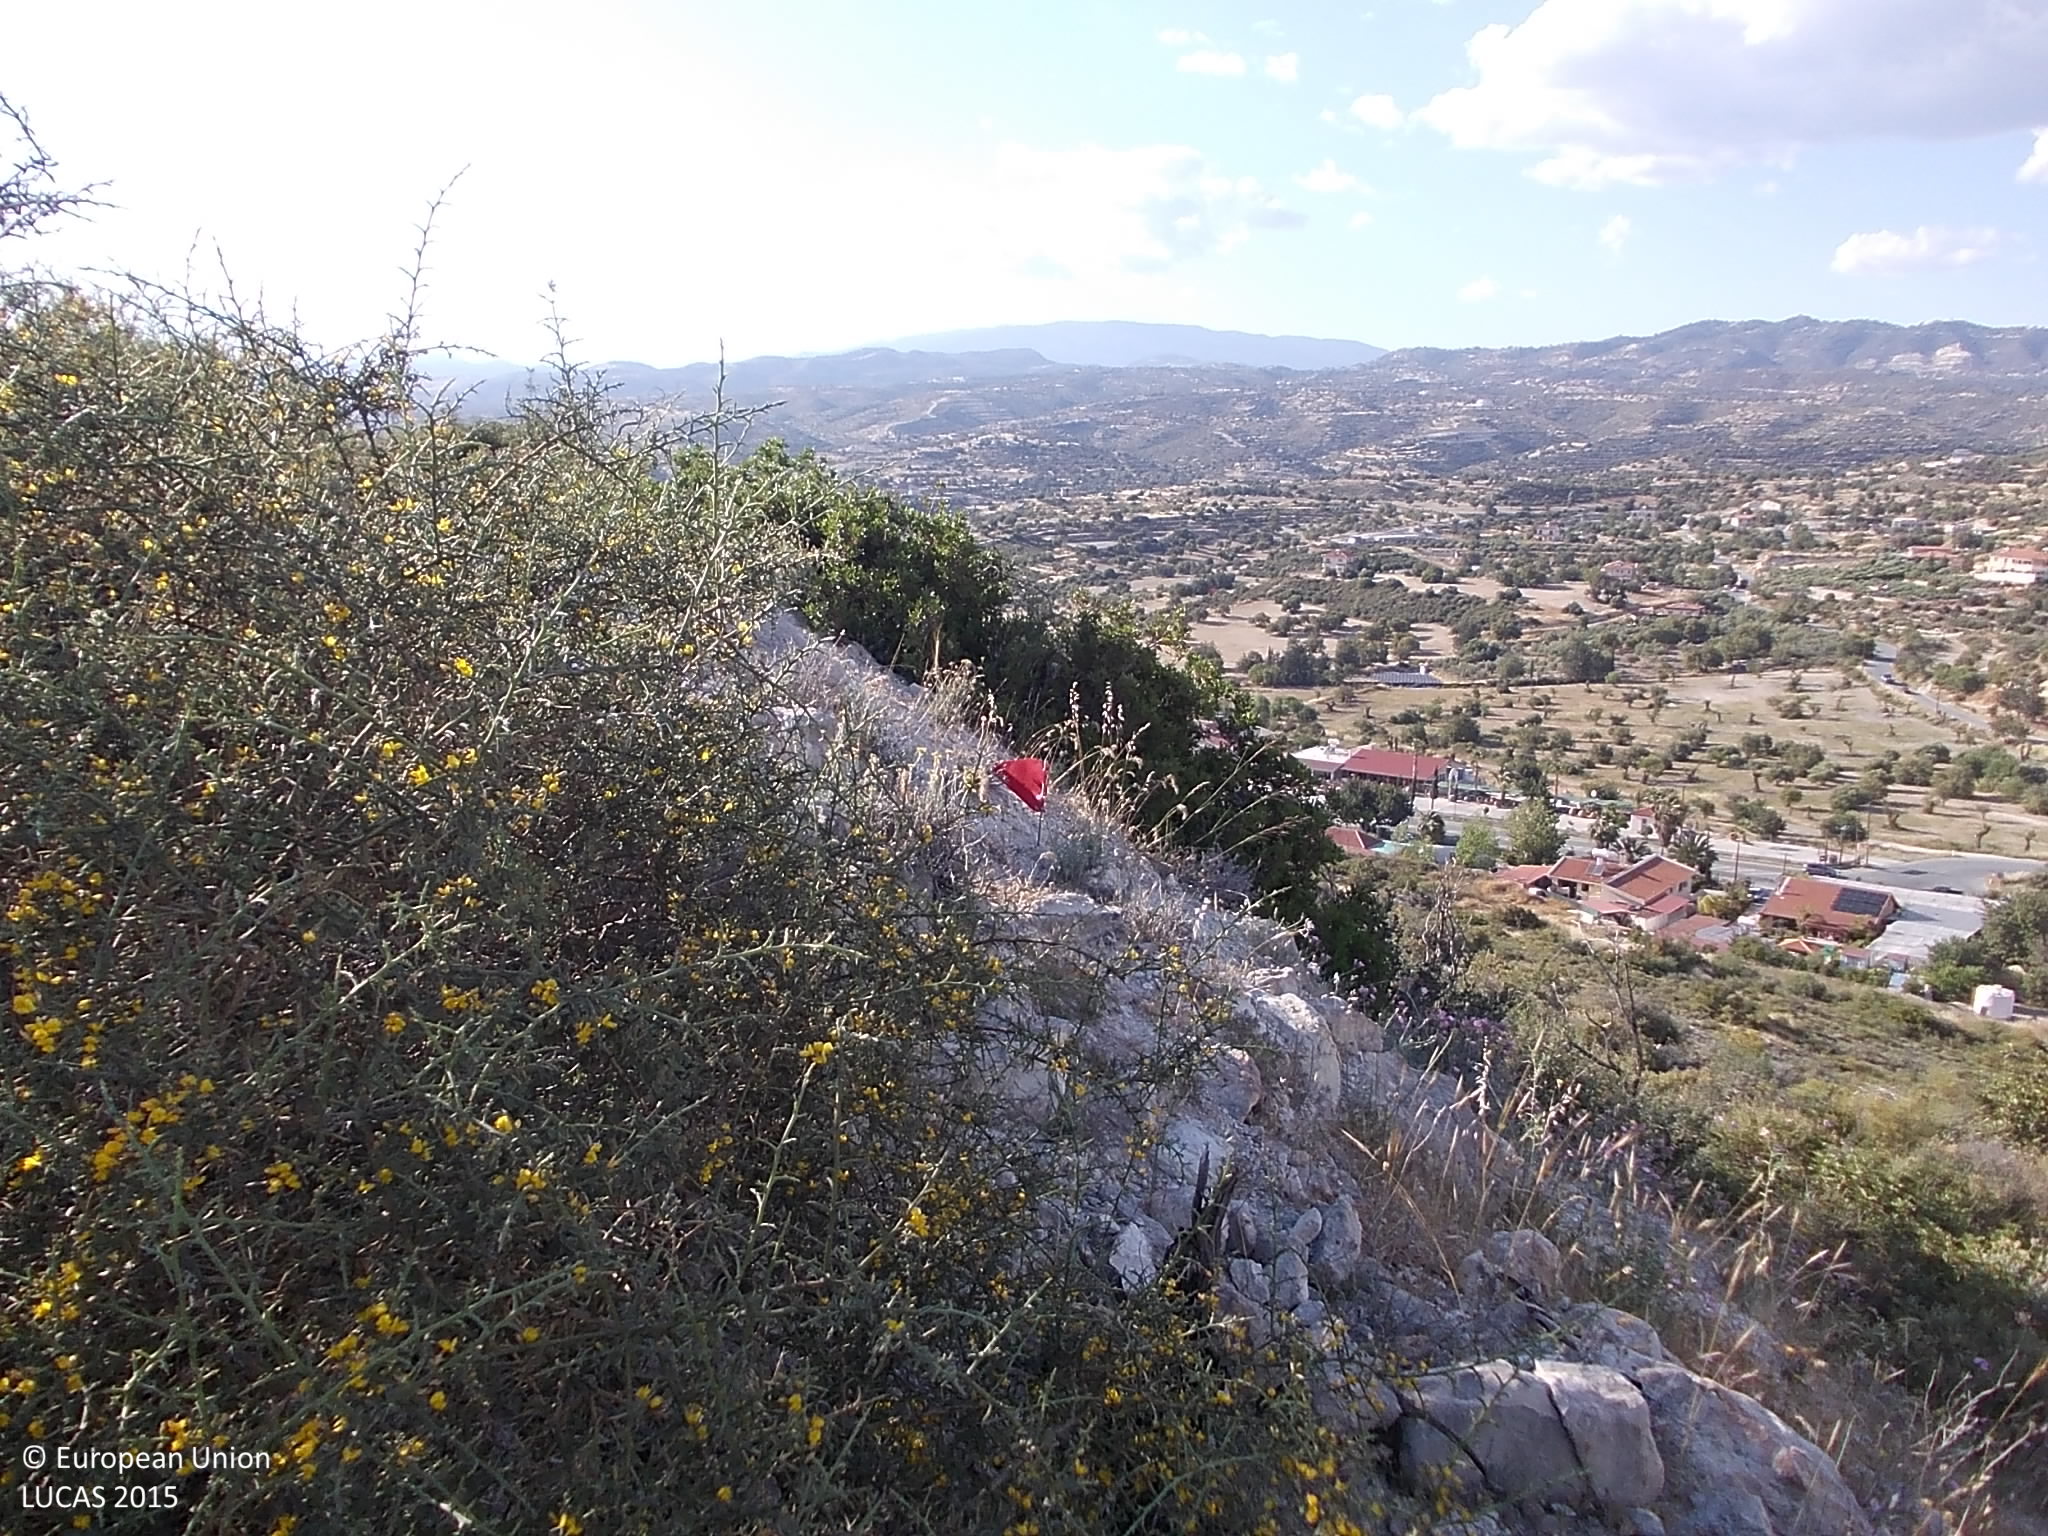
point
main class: Shrubland
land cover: Shrubland without tree cover
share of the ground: 50 - 75 %
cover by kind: shrubs 60 %, unconsolidated bare surface 20 %, herbaceous plants 15 %, consolidated bare surface 5 %
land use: Semi-natural and natural areas not in use
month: May
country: CY
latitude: 34.7424
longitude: 32.9819
